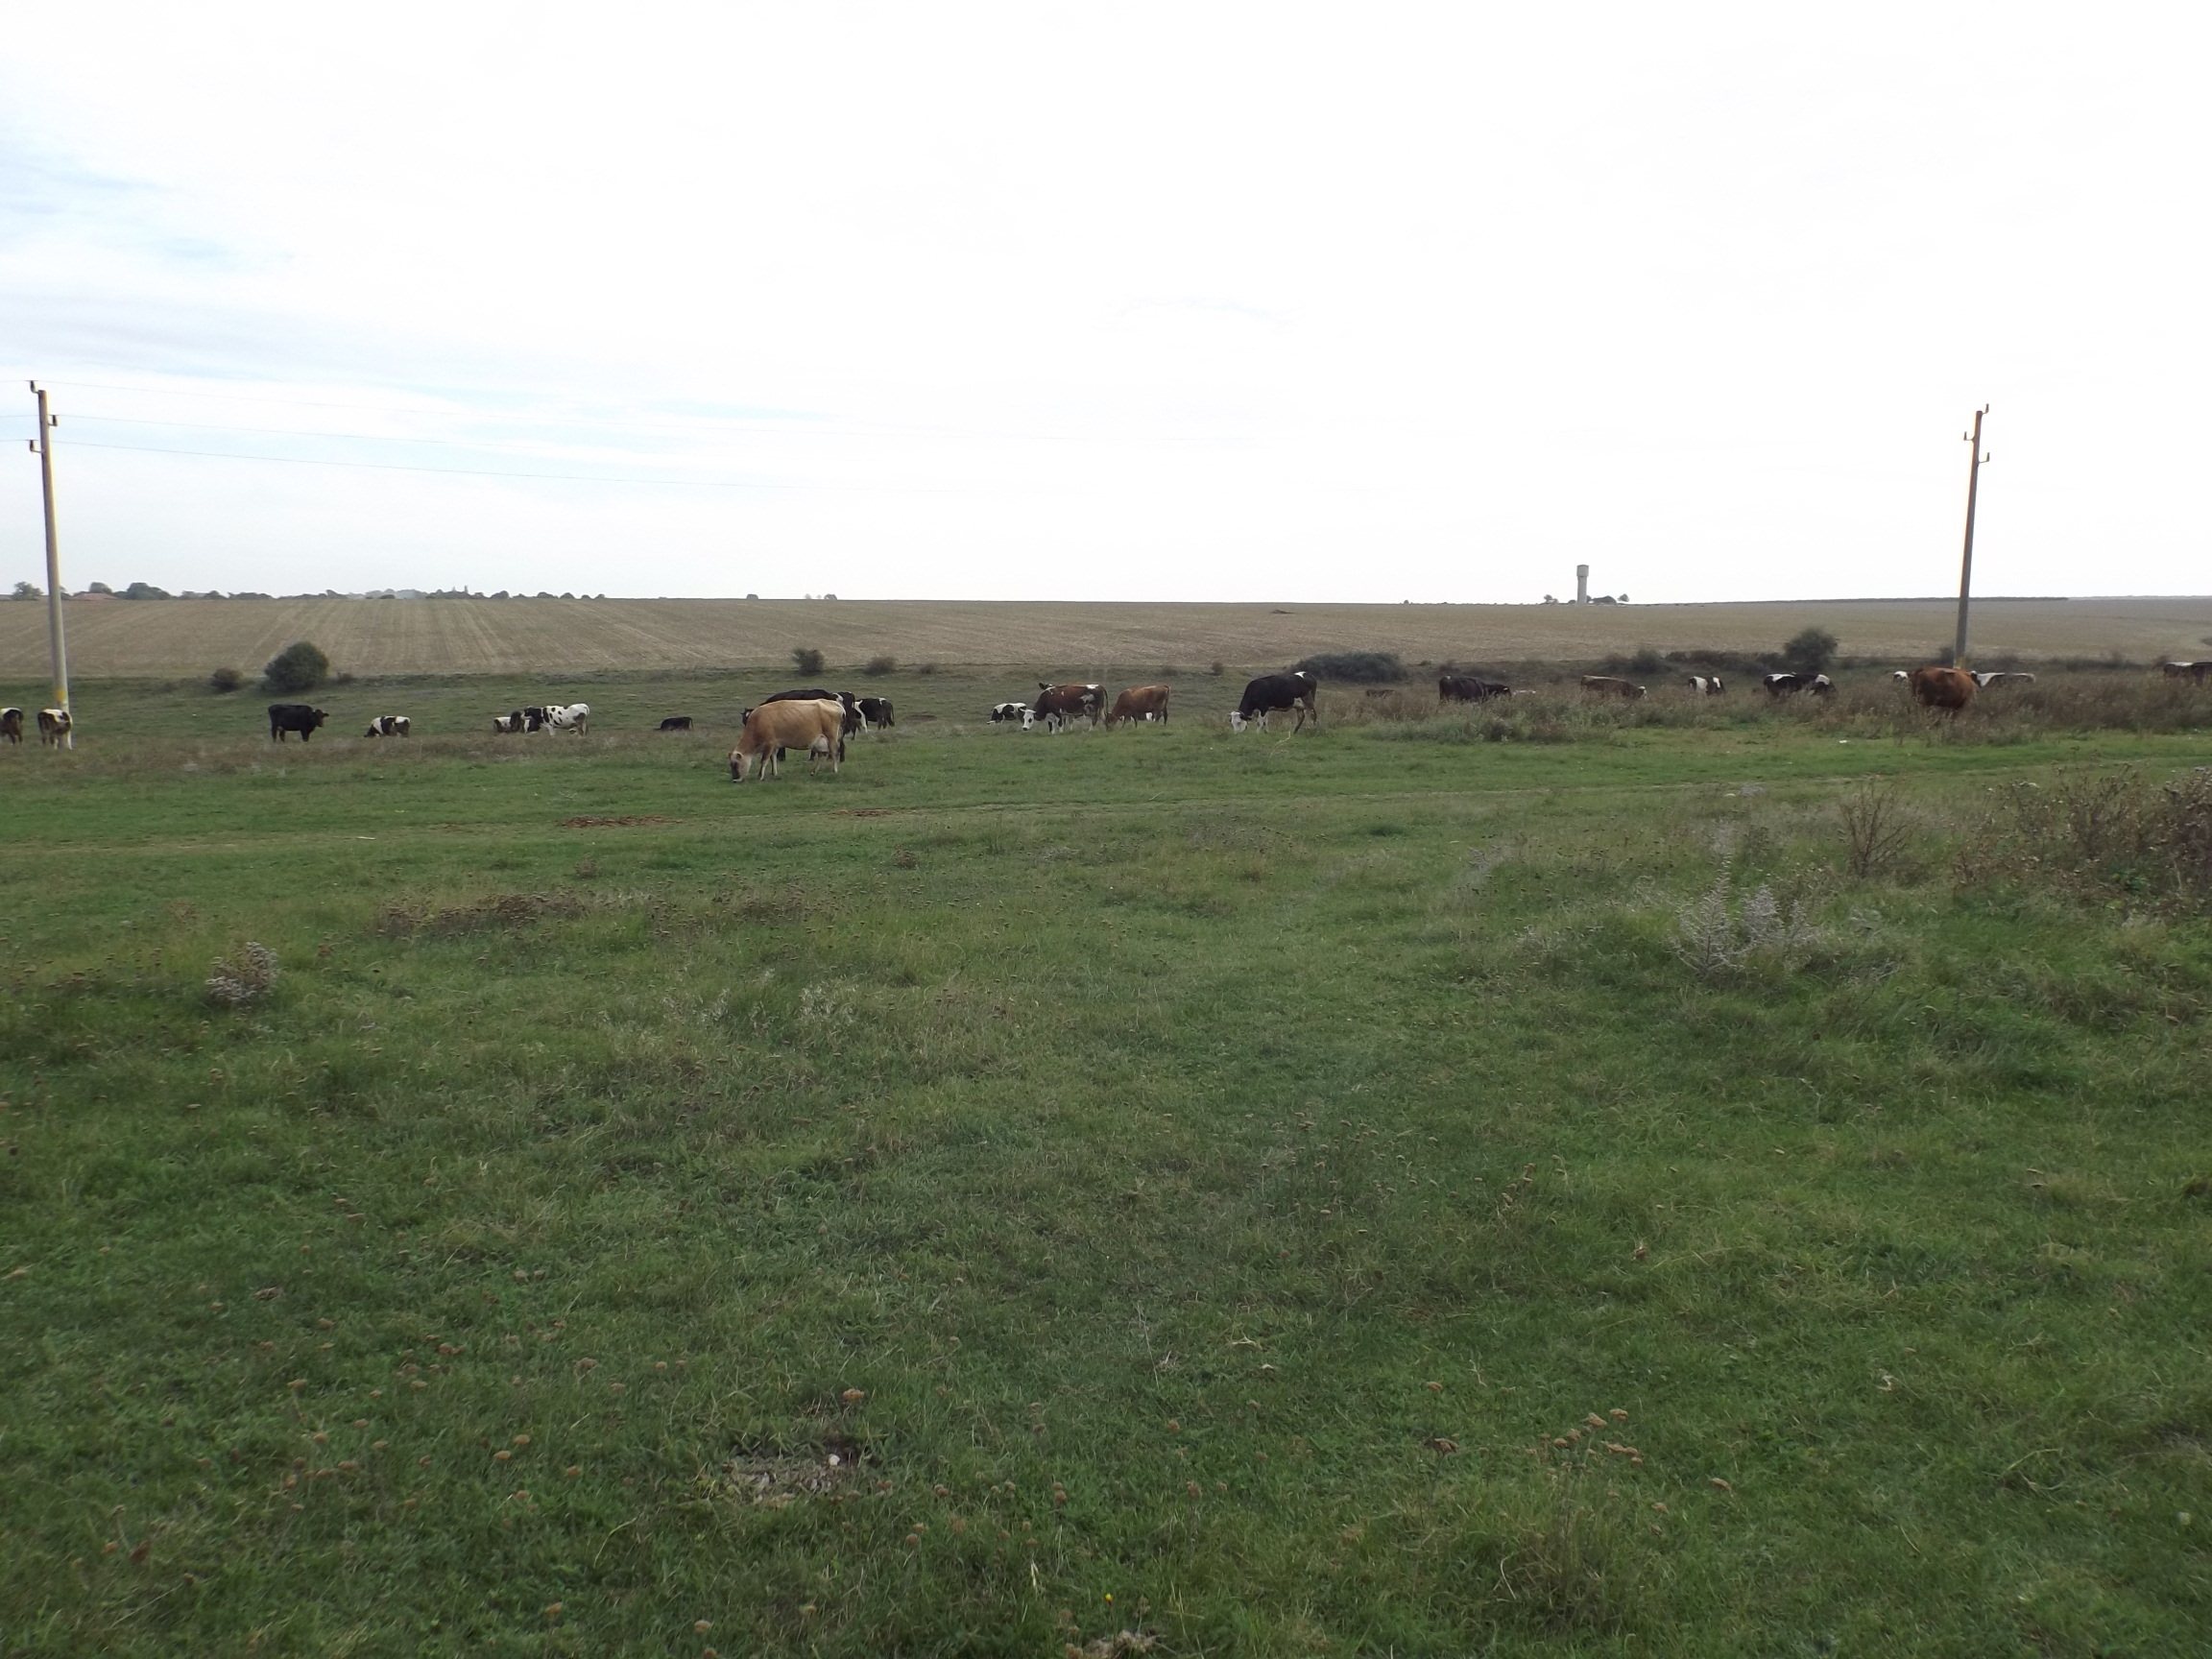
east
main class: Grassland
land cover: Grassland without tree/shrub cover
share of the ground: > 75 %
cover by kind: herbaceous plants 100 %
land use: Agriculture (excluding fallow land and kitchen gardens)
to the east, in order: Grassland without tree/shrub cover; Tracks; Grassland without tree/shrub cover; Electric lines; Grassland without tree/shrub cover; Tracks; Managed hedges; Grassland without tree/shrub cover; Maize
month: October
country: BG
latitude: 43.9141
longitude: 26.8680
